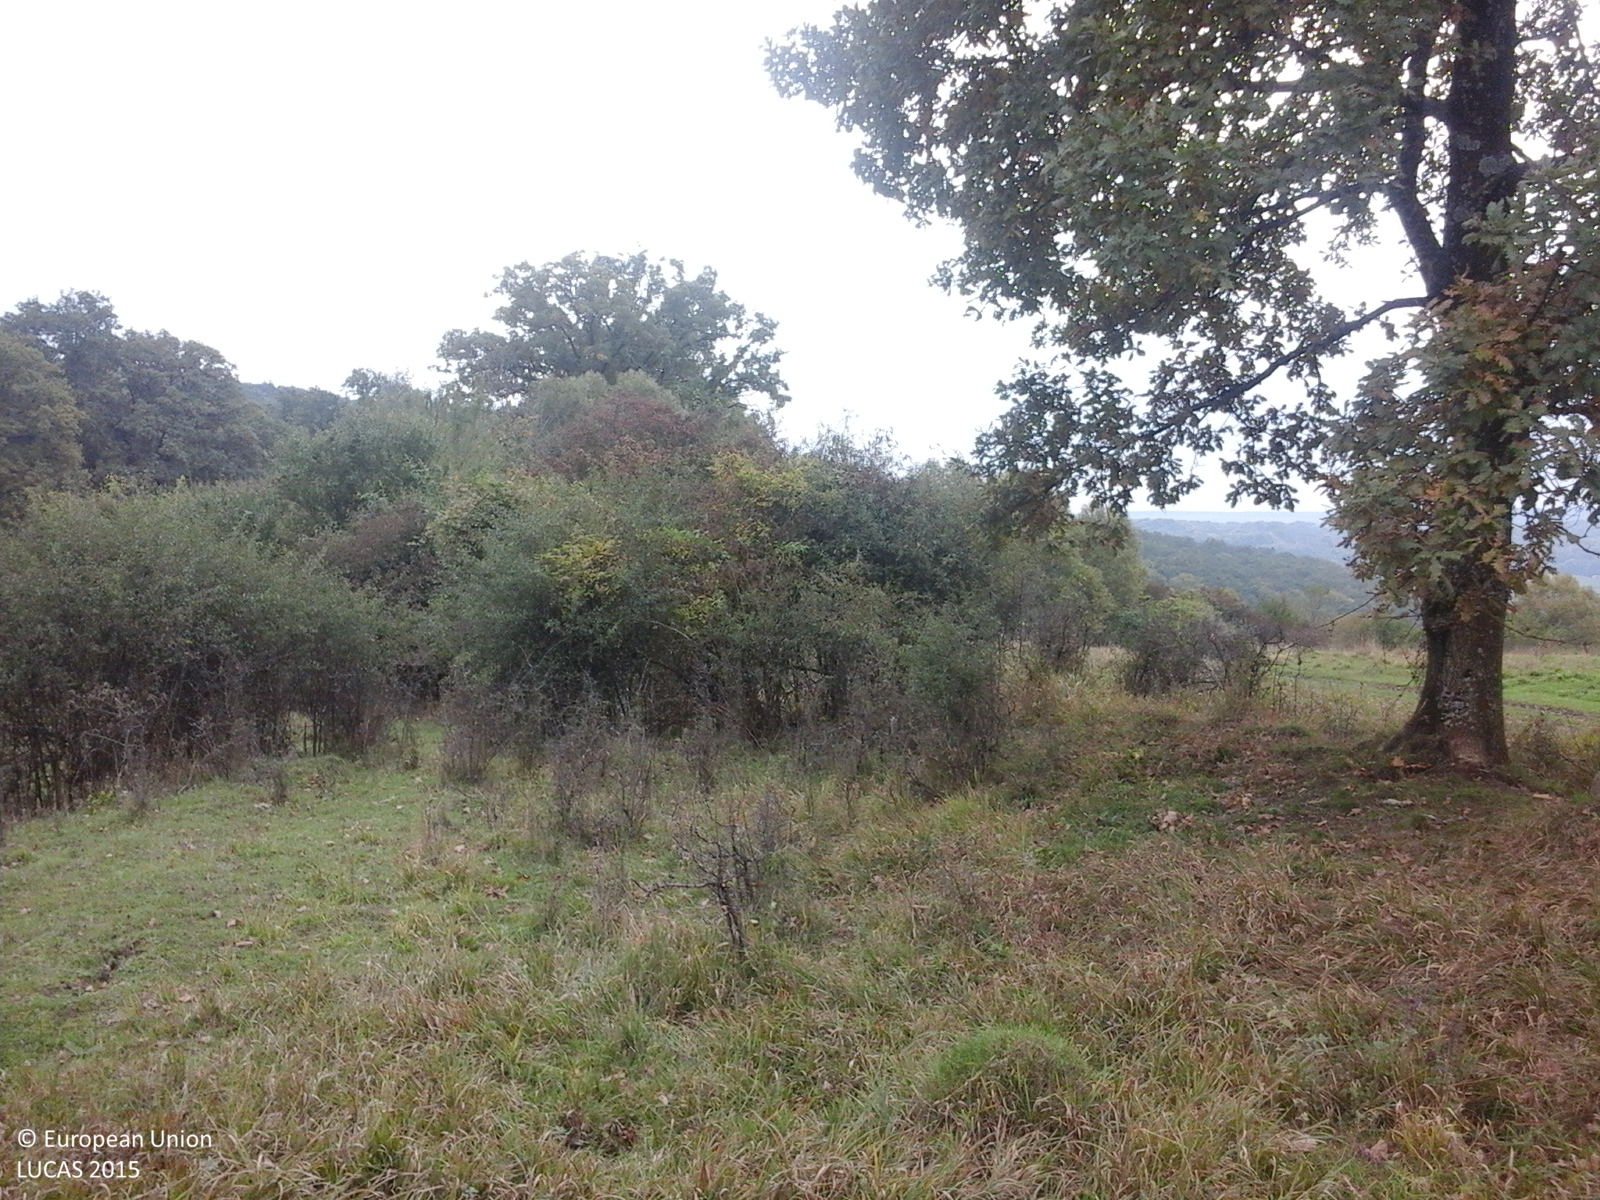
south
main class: Grassland
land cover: Grassland with sparse tree/shrub cover
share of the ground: > 75 %
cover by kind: herbaceous plants 85 %, shrubs 10 %, broadleaved forest trees 5 %
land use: Agriculture (excluding fallow land and kitchen gardens)
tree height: > 5 m
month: October
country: RO
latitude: 46.1545
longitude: 24.8133
